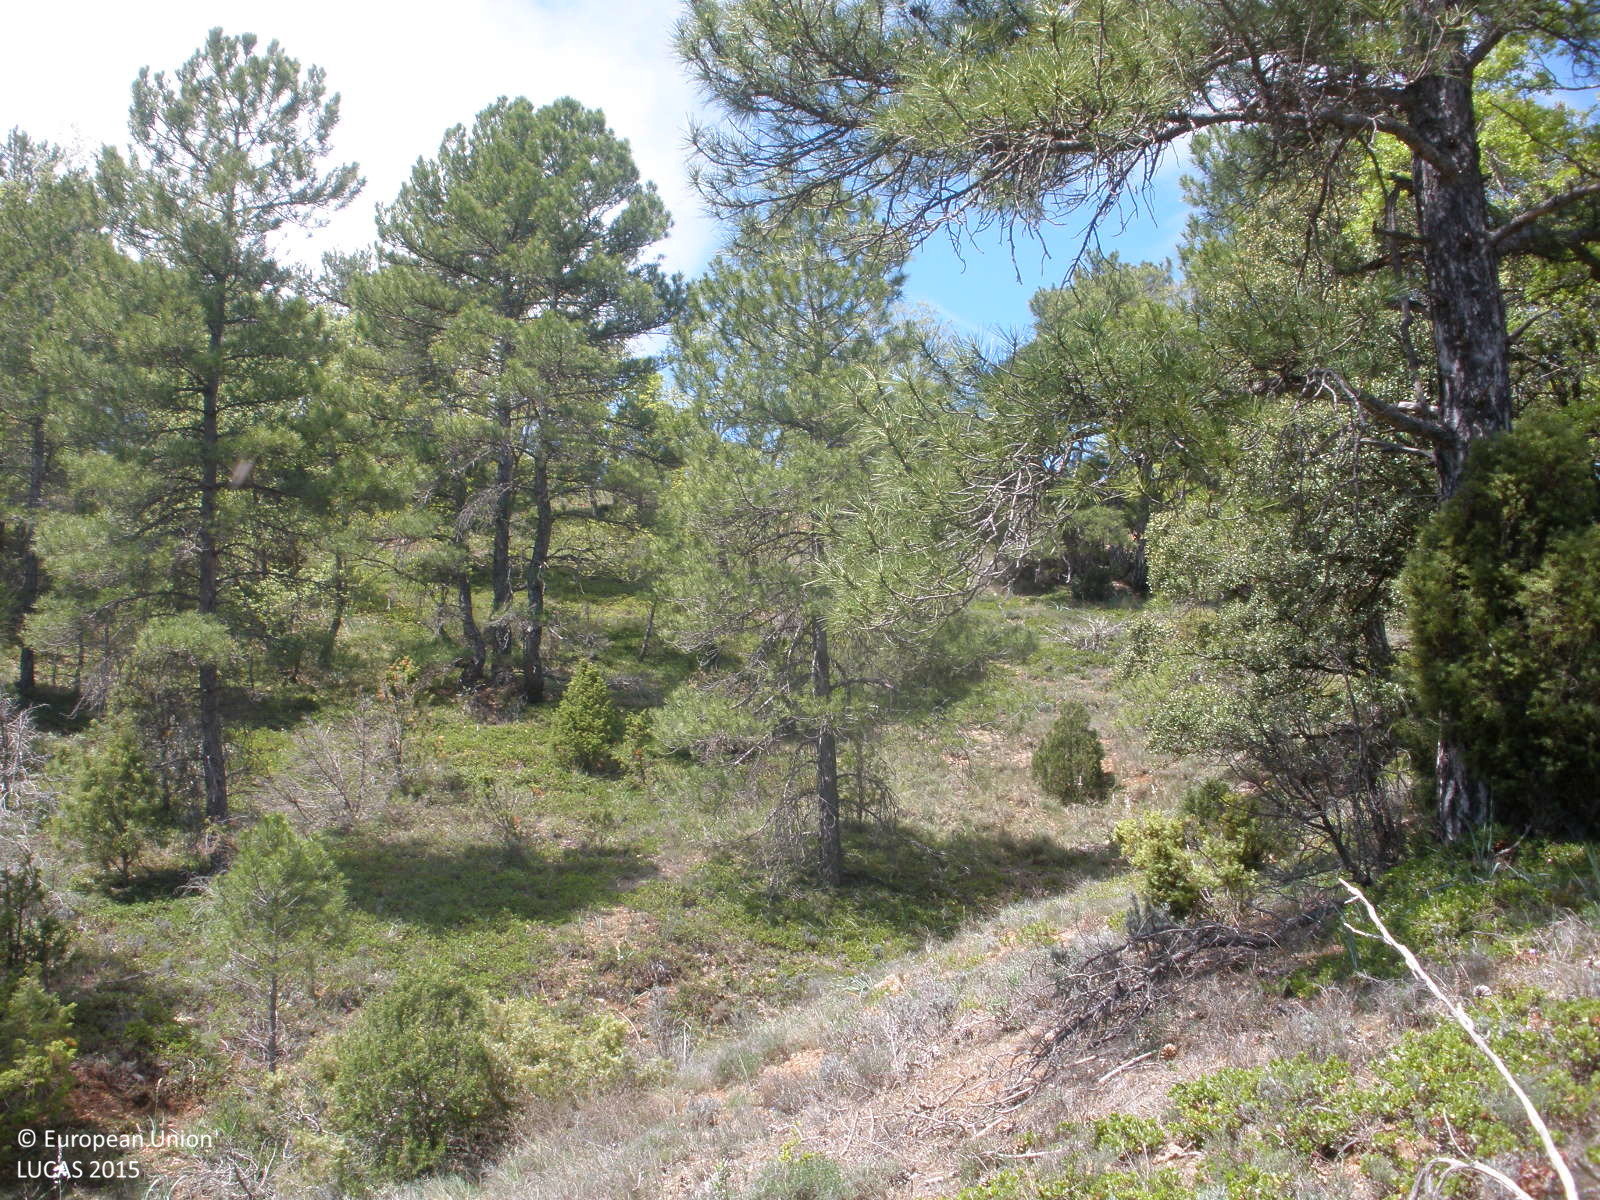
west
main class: Woodland
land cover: Pine dominated coniferous woodland
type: coniferous forest of the mediterranean region
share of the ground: 25 - 50 %
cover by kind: shrubs 60 %, coniferous forest trees 30 %, consolidated bare surface 10 %
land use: Semi-natural and natural areas not in use
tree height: > 5 m
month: May
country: ES
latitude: 40.9134
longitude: -0.9264
